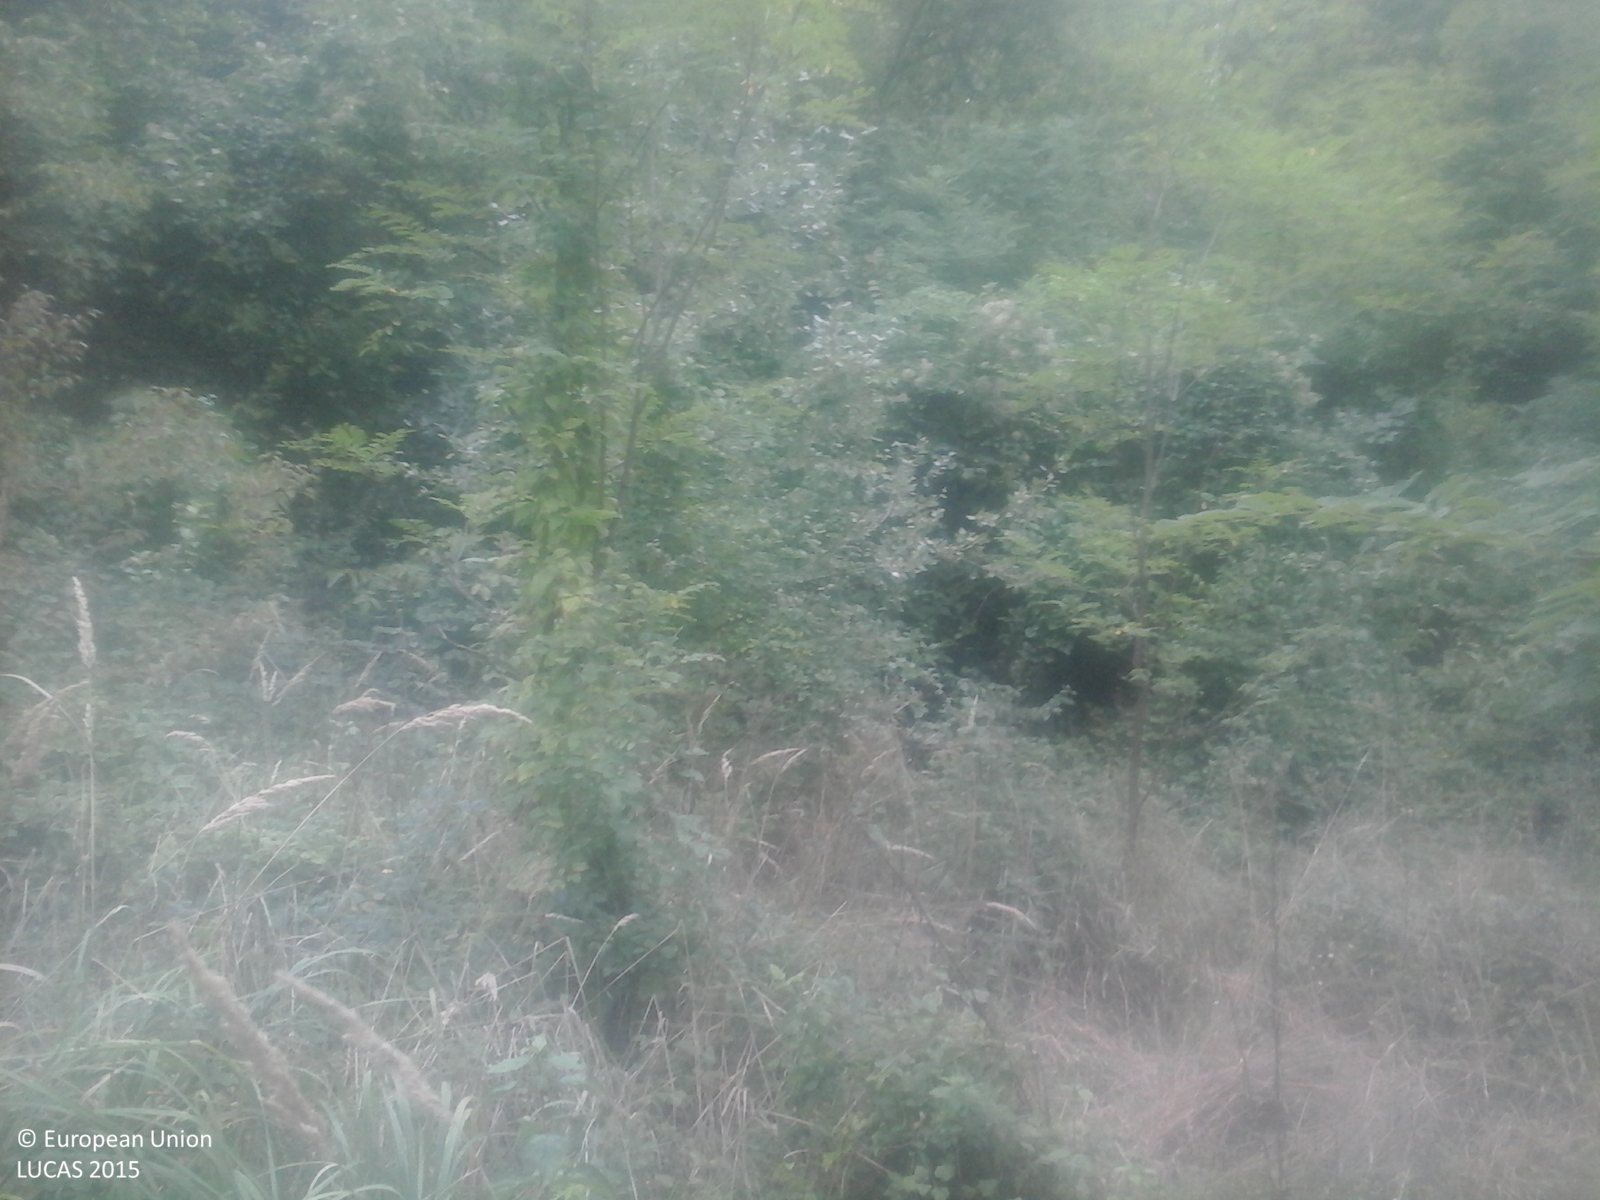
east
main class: Woodland
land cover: Broadleaved woodland
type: exotic forest
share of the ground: > 75 %
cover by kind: broadleaved forest trees 100 %
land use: Forestry
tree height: > 5 m
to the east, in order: Broadleaved woodland; Arable land (only in case pi); Broadleaved woodland; Grassland with sparse tree/shrub cover; Tracks; Grassland with sparse tree/shrub cover; Tracks; Arable land (only in case pi)
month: September
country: RO
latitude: 44.7832
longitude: 23.1817
